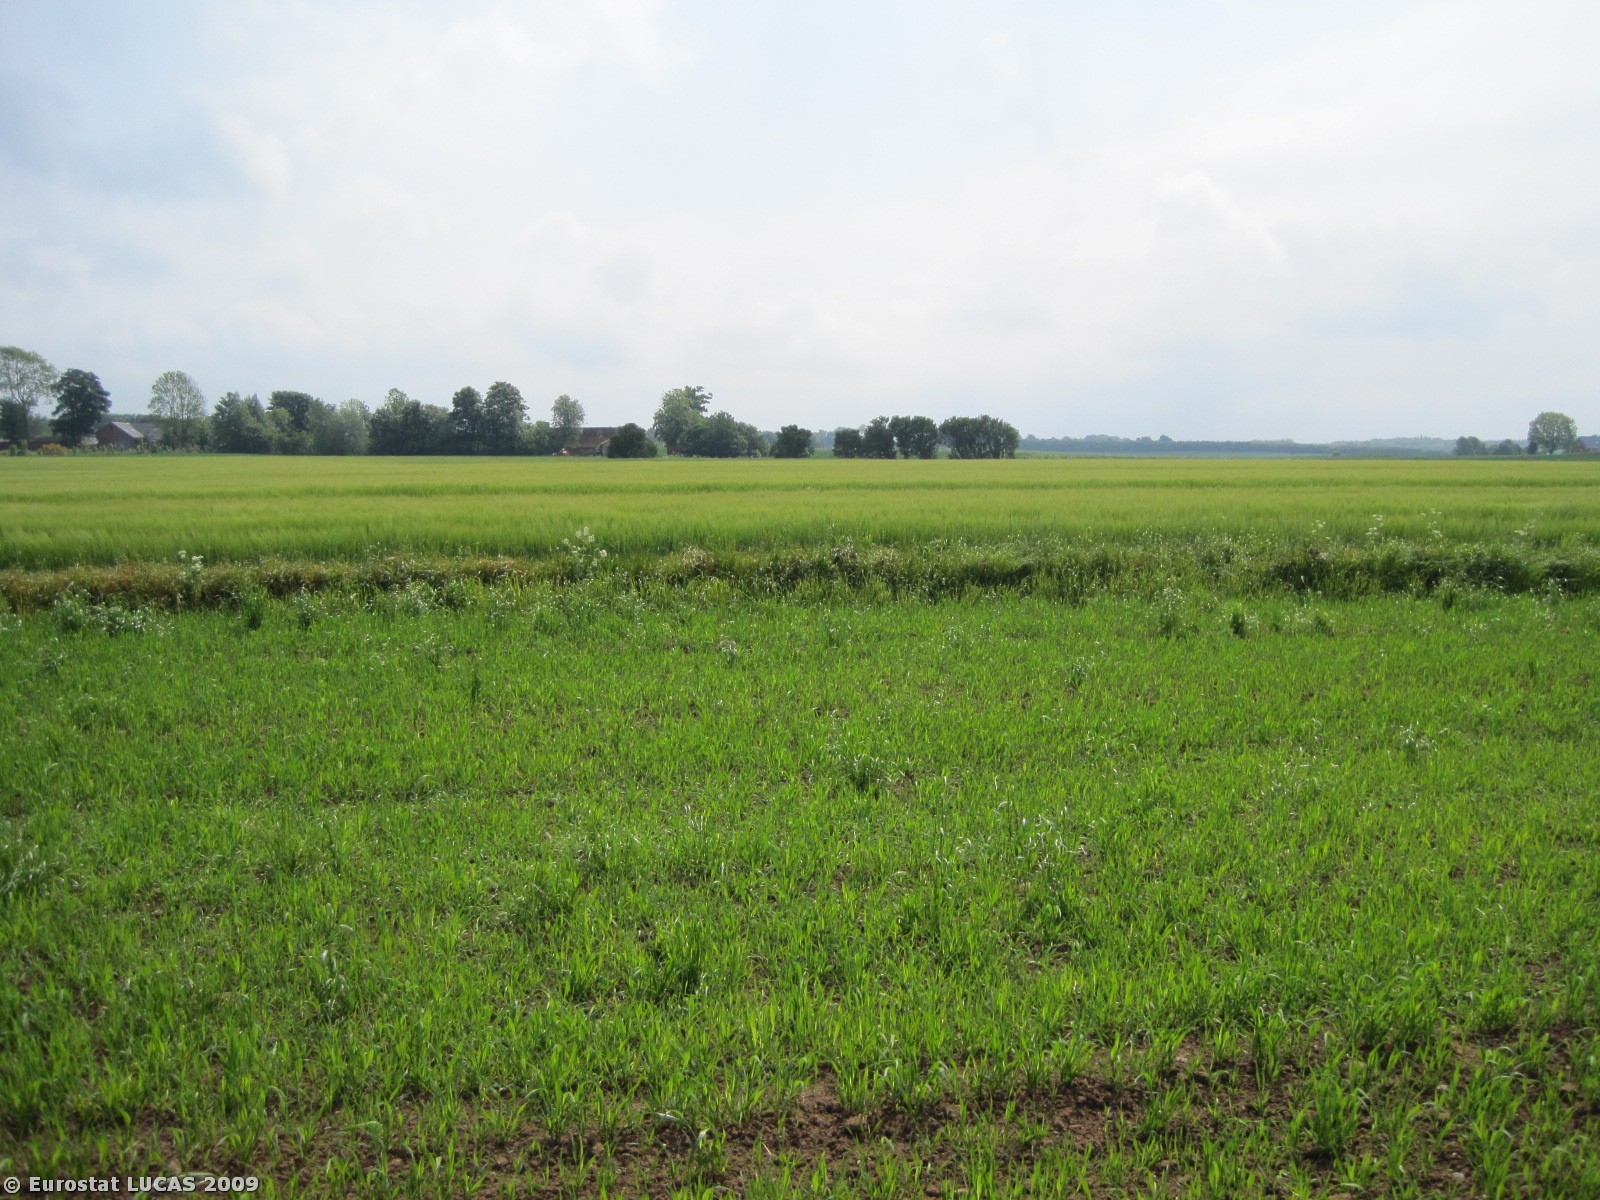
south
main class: Cropland
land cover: Oats
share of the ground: > 75 %
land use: Agriculture (excluding fallow land and kitchen gardens)
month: May
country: DK
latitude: 56.4213
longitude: 9.7895
